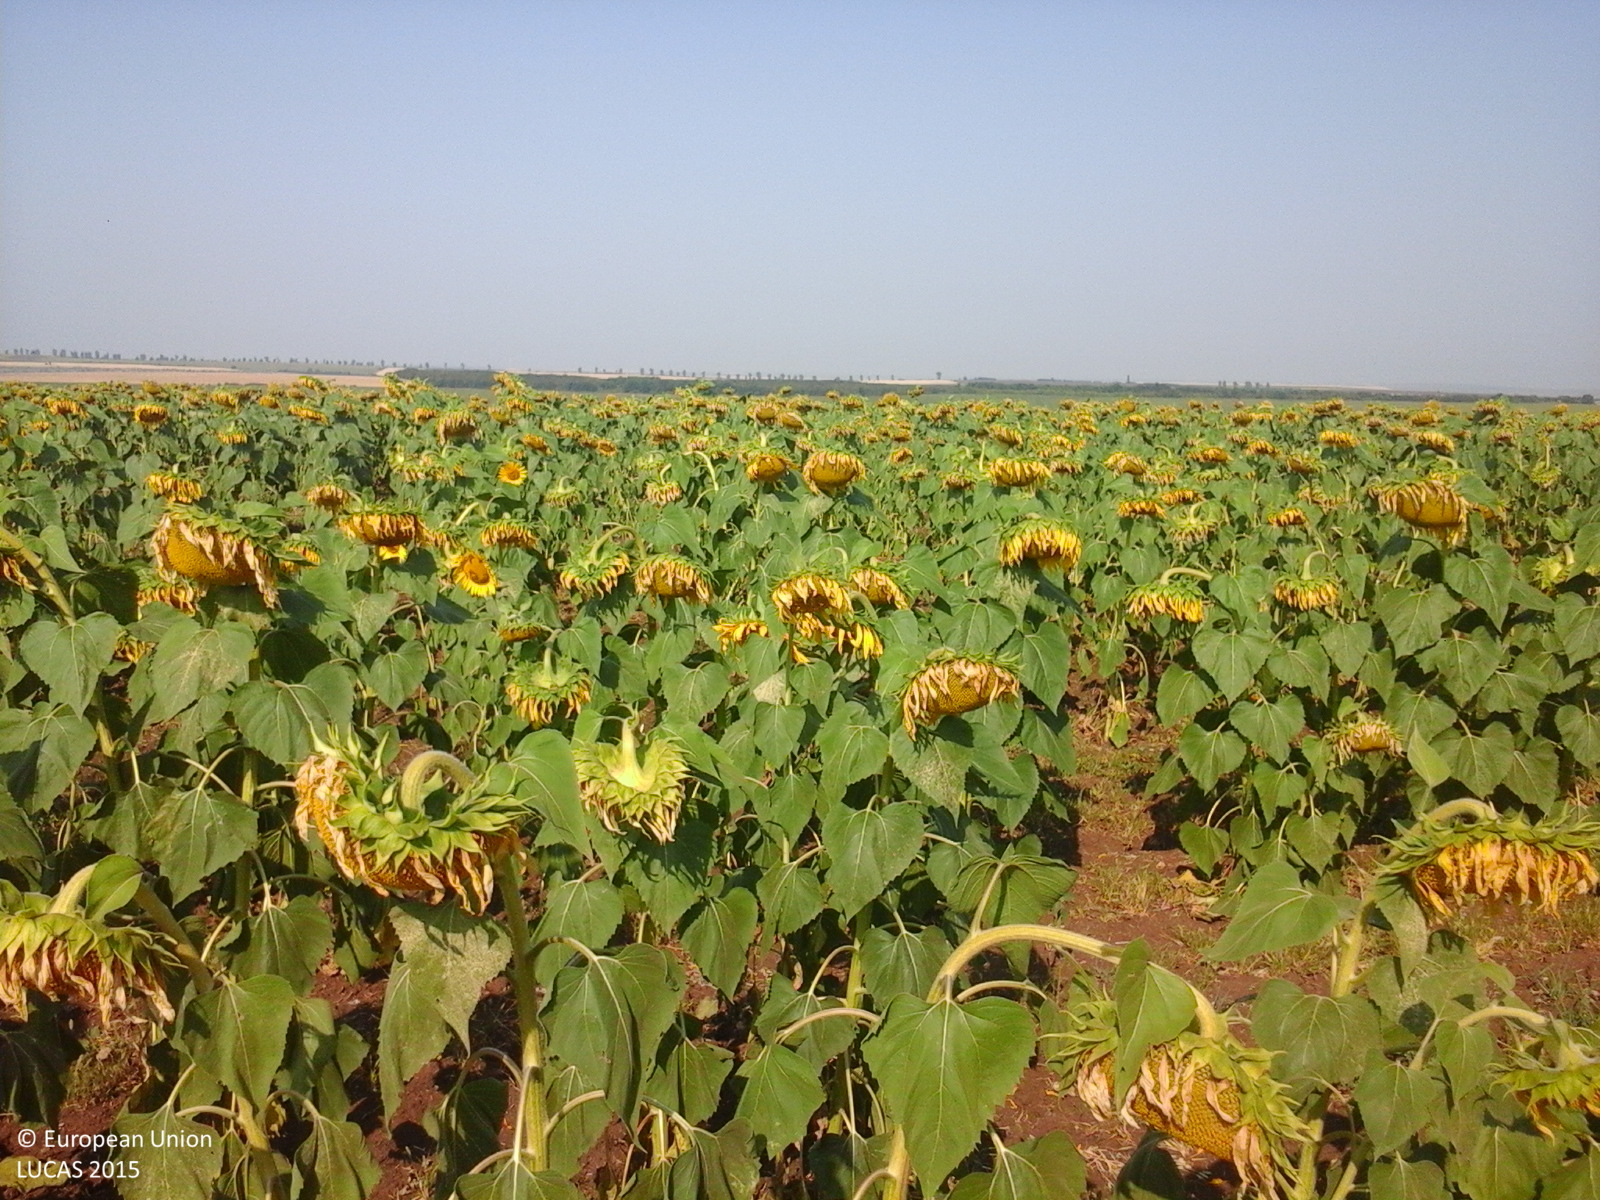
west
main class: Cropland
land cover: Sunflower
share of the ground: > 75 %
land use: Agriculture (excluding fallow land and kitchen gardens)
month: July
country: RO
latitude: 45.9657
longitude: 28.0211
